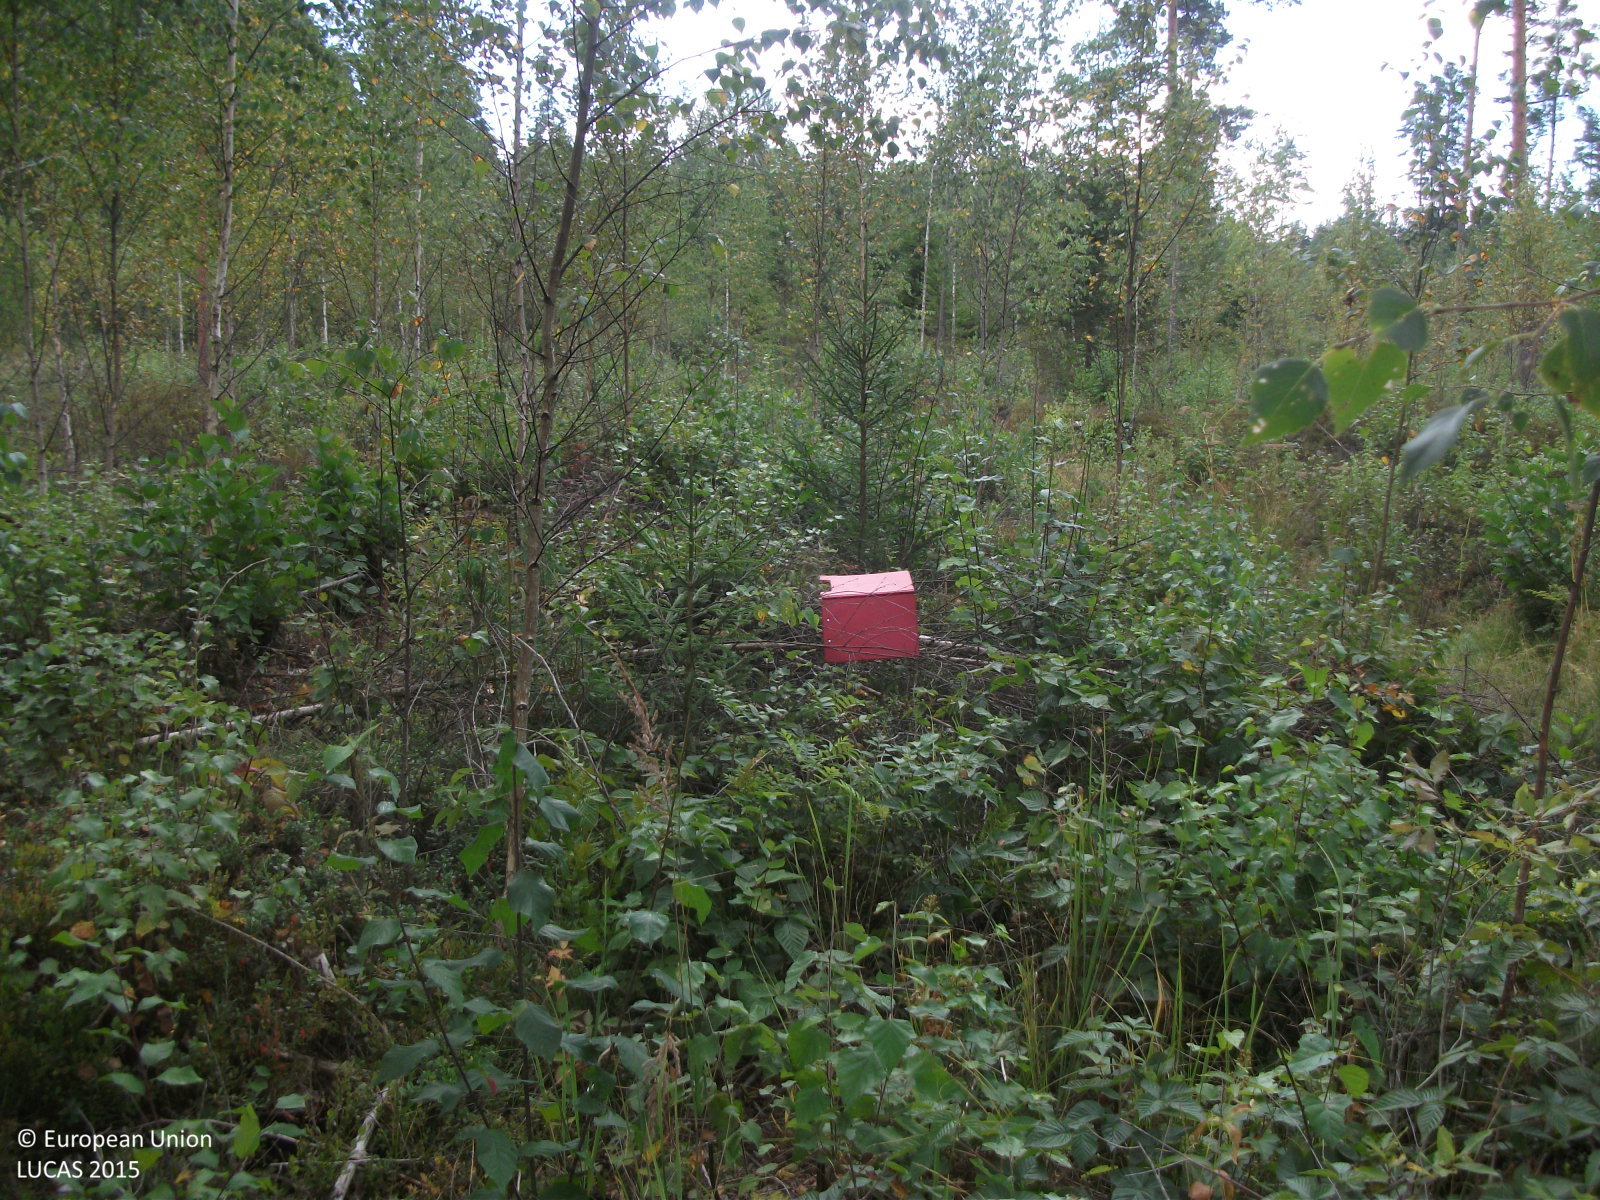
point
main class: Woodland
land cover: Broadleaved woodland
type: non-riverine alder, birch or aspen forest
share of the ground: 50 - 75 %
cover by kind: broadleaved forest trees 60 %, shrubs 20 %, herbaceous plants 10 %, lichens and mosses 10 %
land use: Forestry
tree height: < 5 m
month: September
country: LV
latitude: 56.5639
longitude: 26.2001
